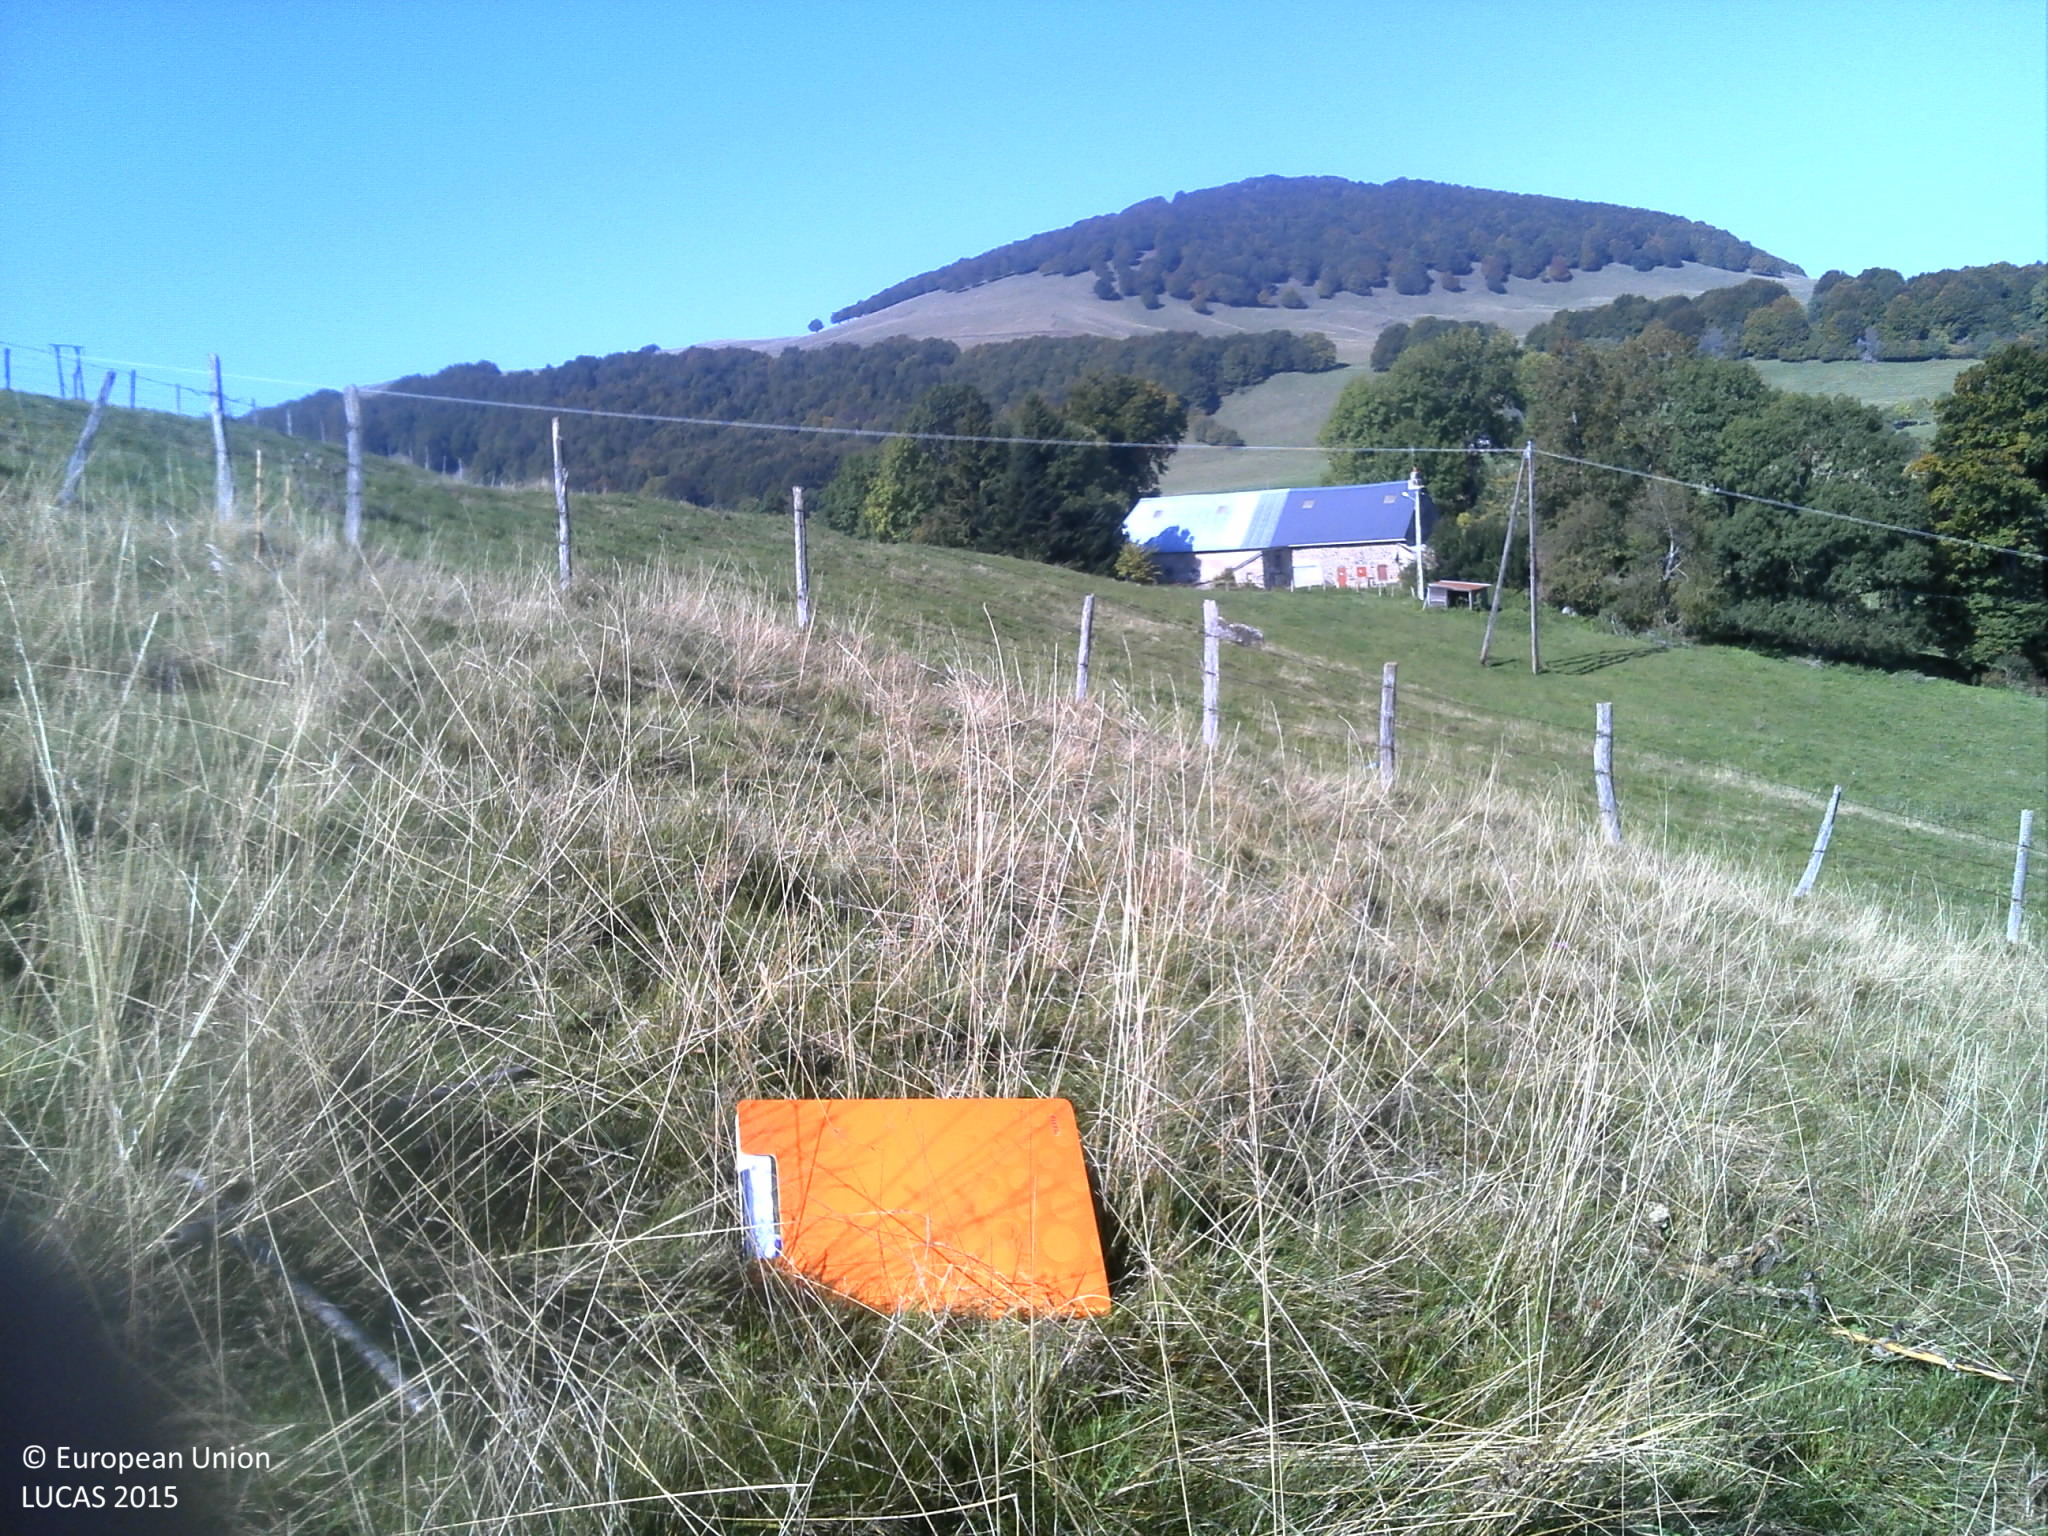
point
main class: Grassland
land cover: Grassland without tree/shrub cover
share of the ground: > 75 %
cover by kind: herbaceous plants 100 %
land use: Agriculture (excluding fallow land and kitchen gardens)
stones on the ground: < 10 %
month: October
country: FR
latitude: 45.4284
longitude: 2.9066
